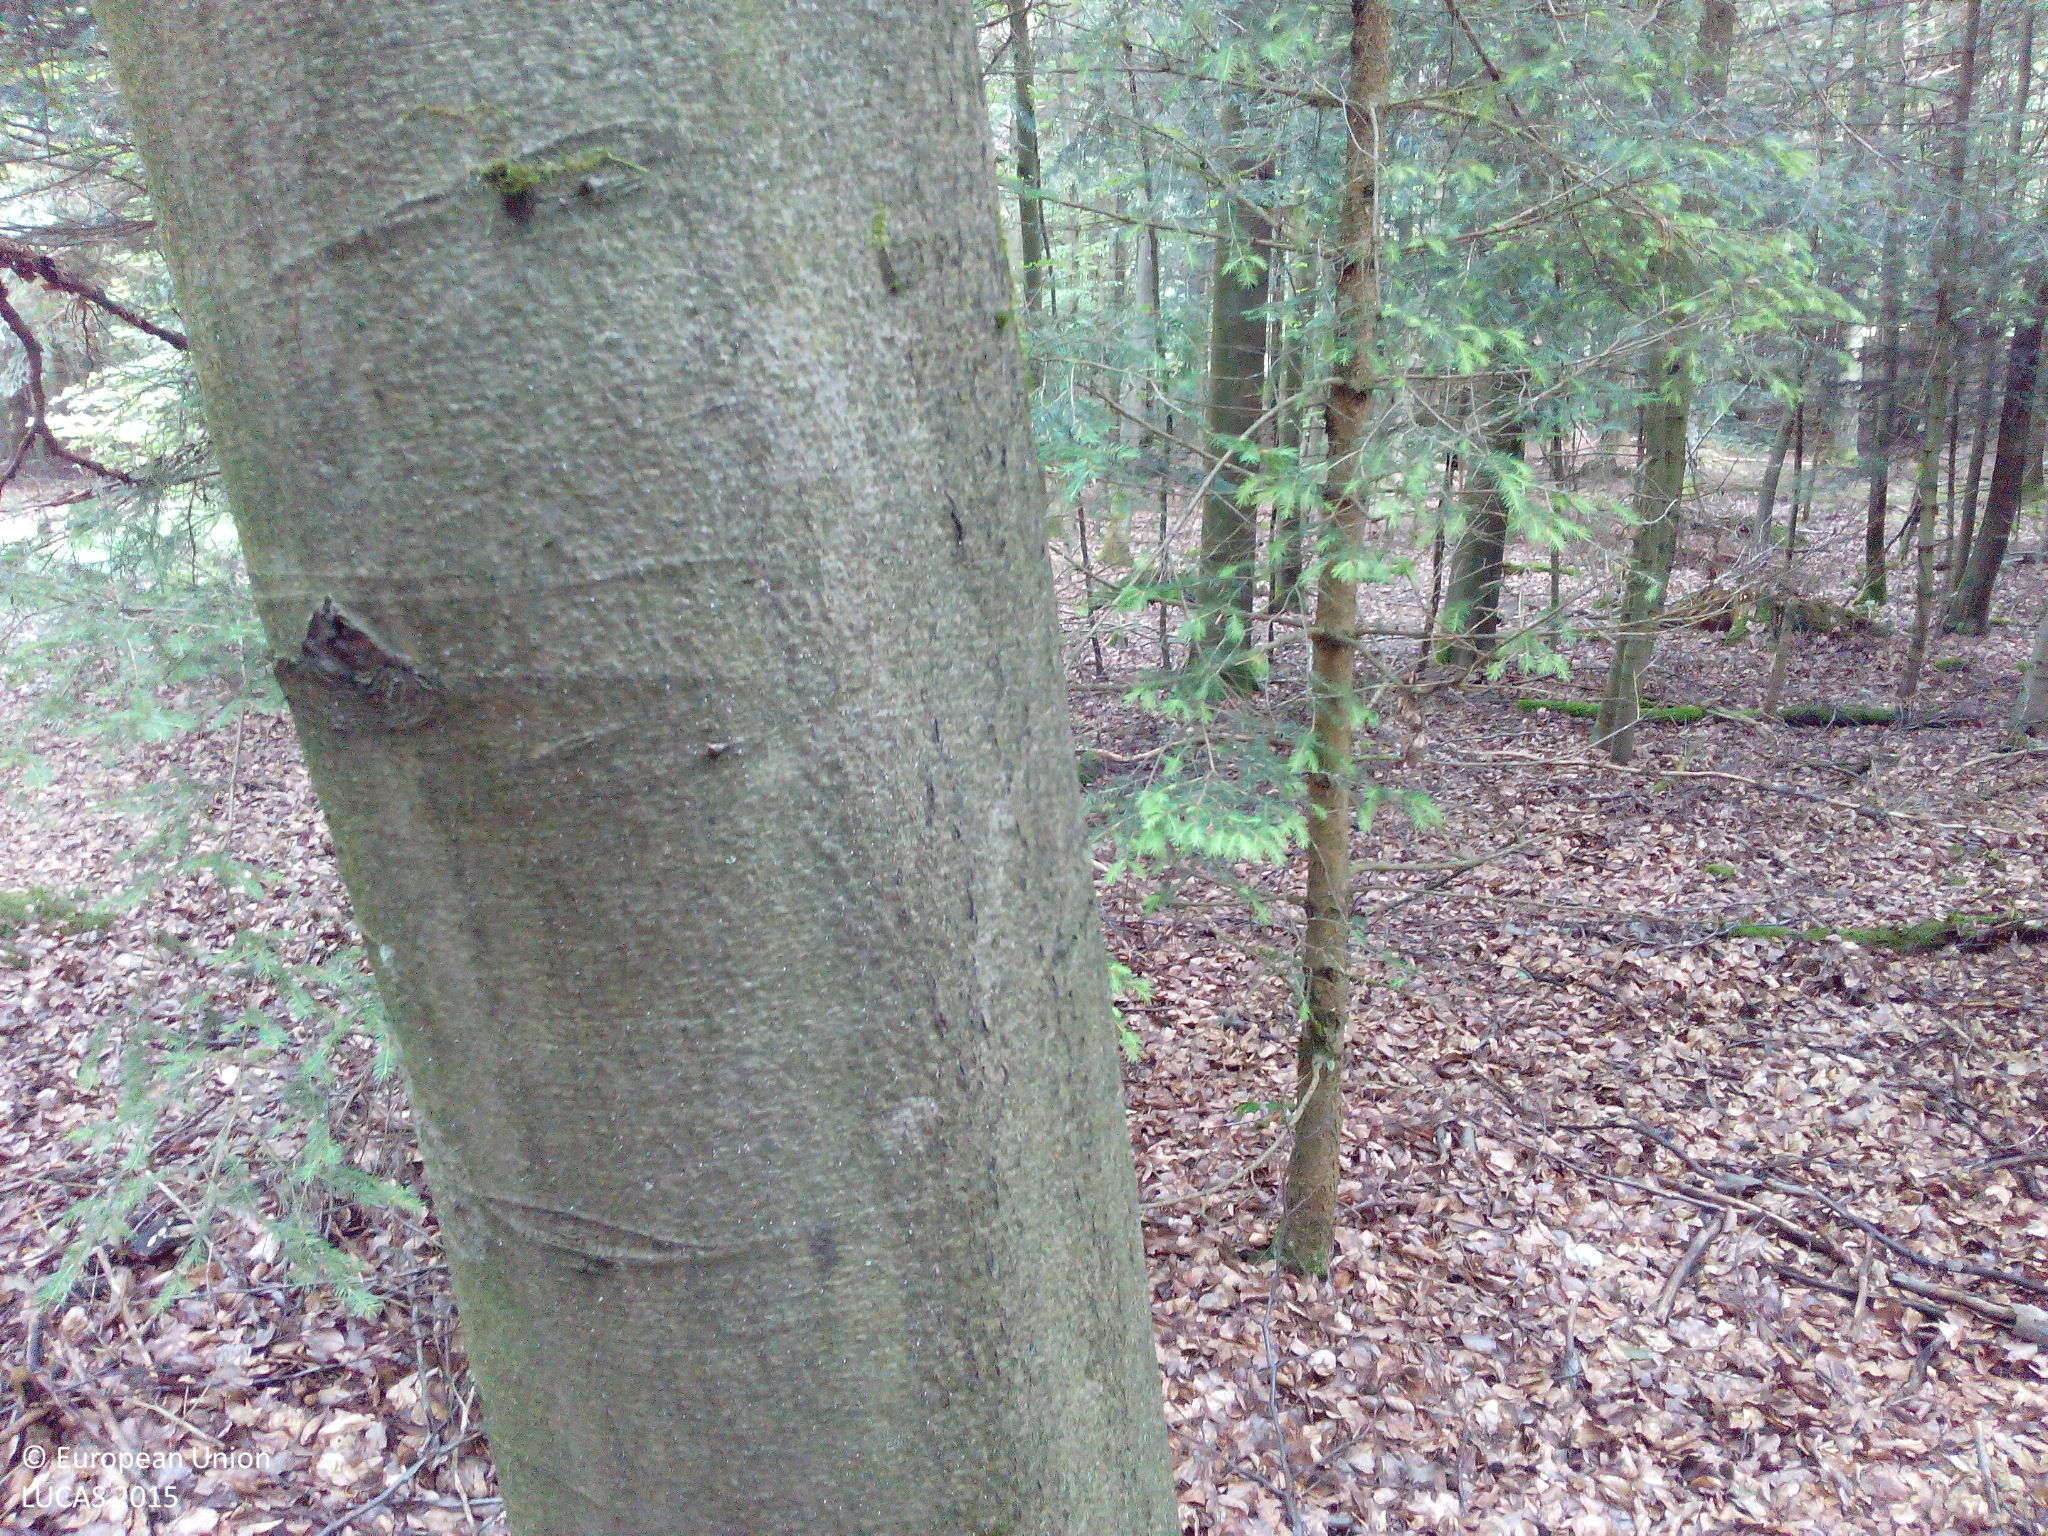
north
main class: Woodland
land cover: Spruce dominated mixed woodland
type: hemiboreal forest and nemoral coniferous forest and mixed broadleaved-coniferous forest
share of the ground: > 75 %
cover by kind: broadleaved forest trees 50 %, coniferous forest trees 30 %, unconsolidated bare surface 15 %, lichens and mosses 5 %
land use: Forestry
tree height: > 5 m
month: June
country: DE
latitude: 48.9626
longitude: 11.9252
